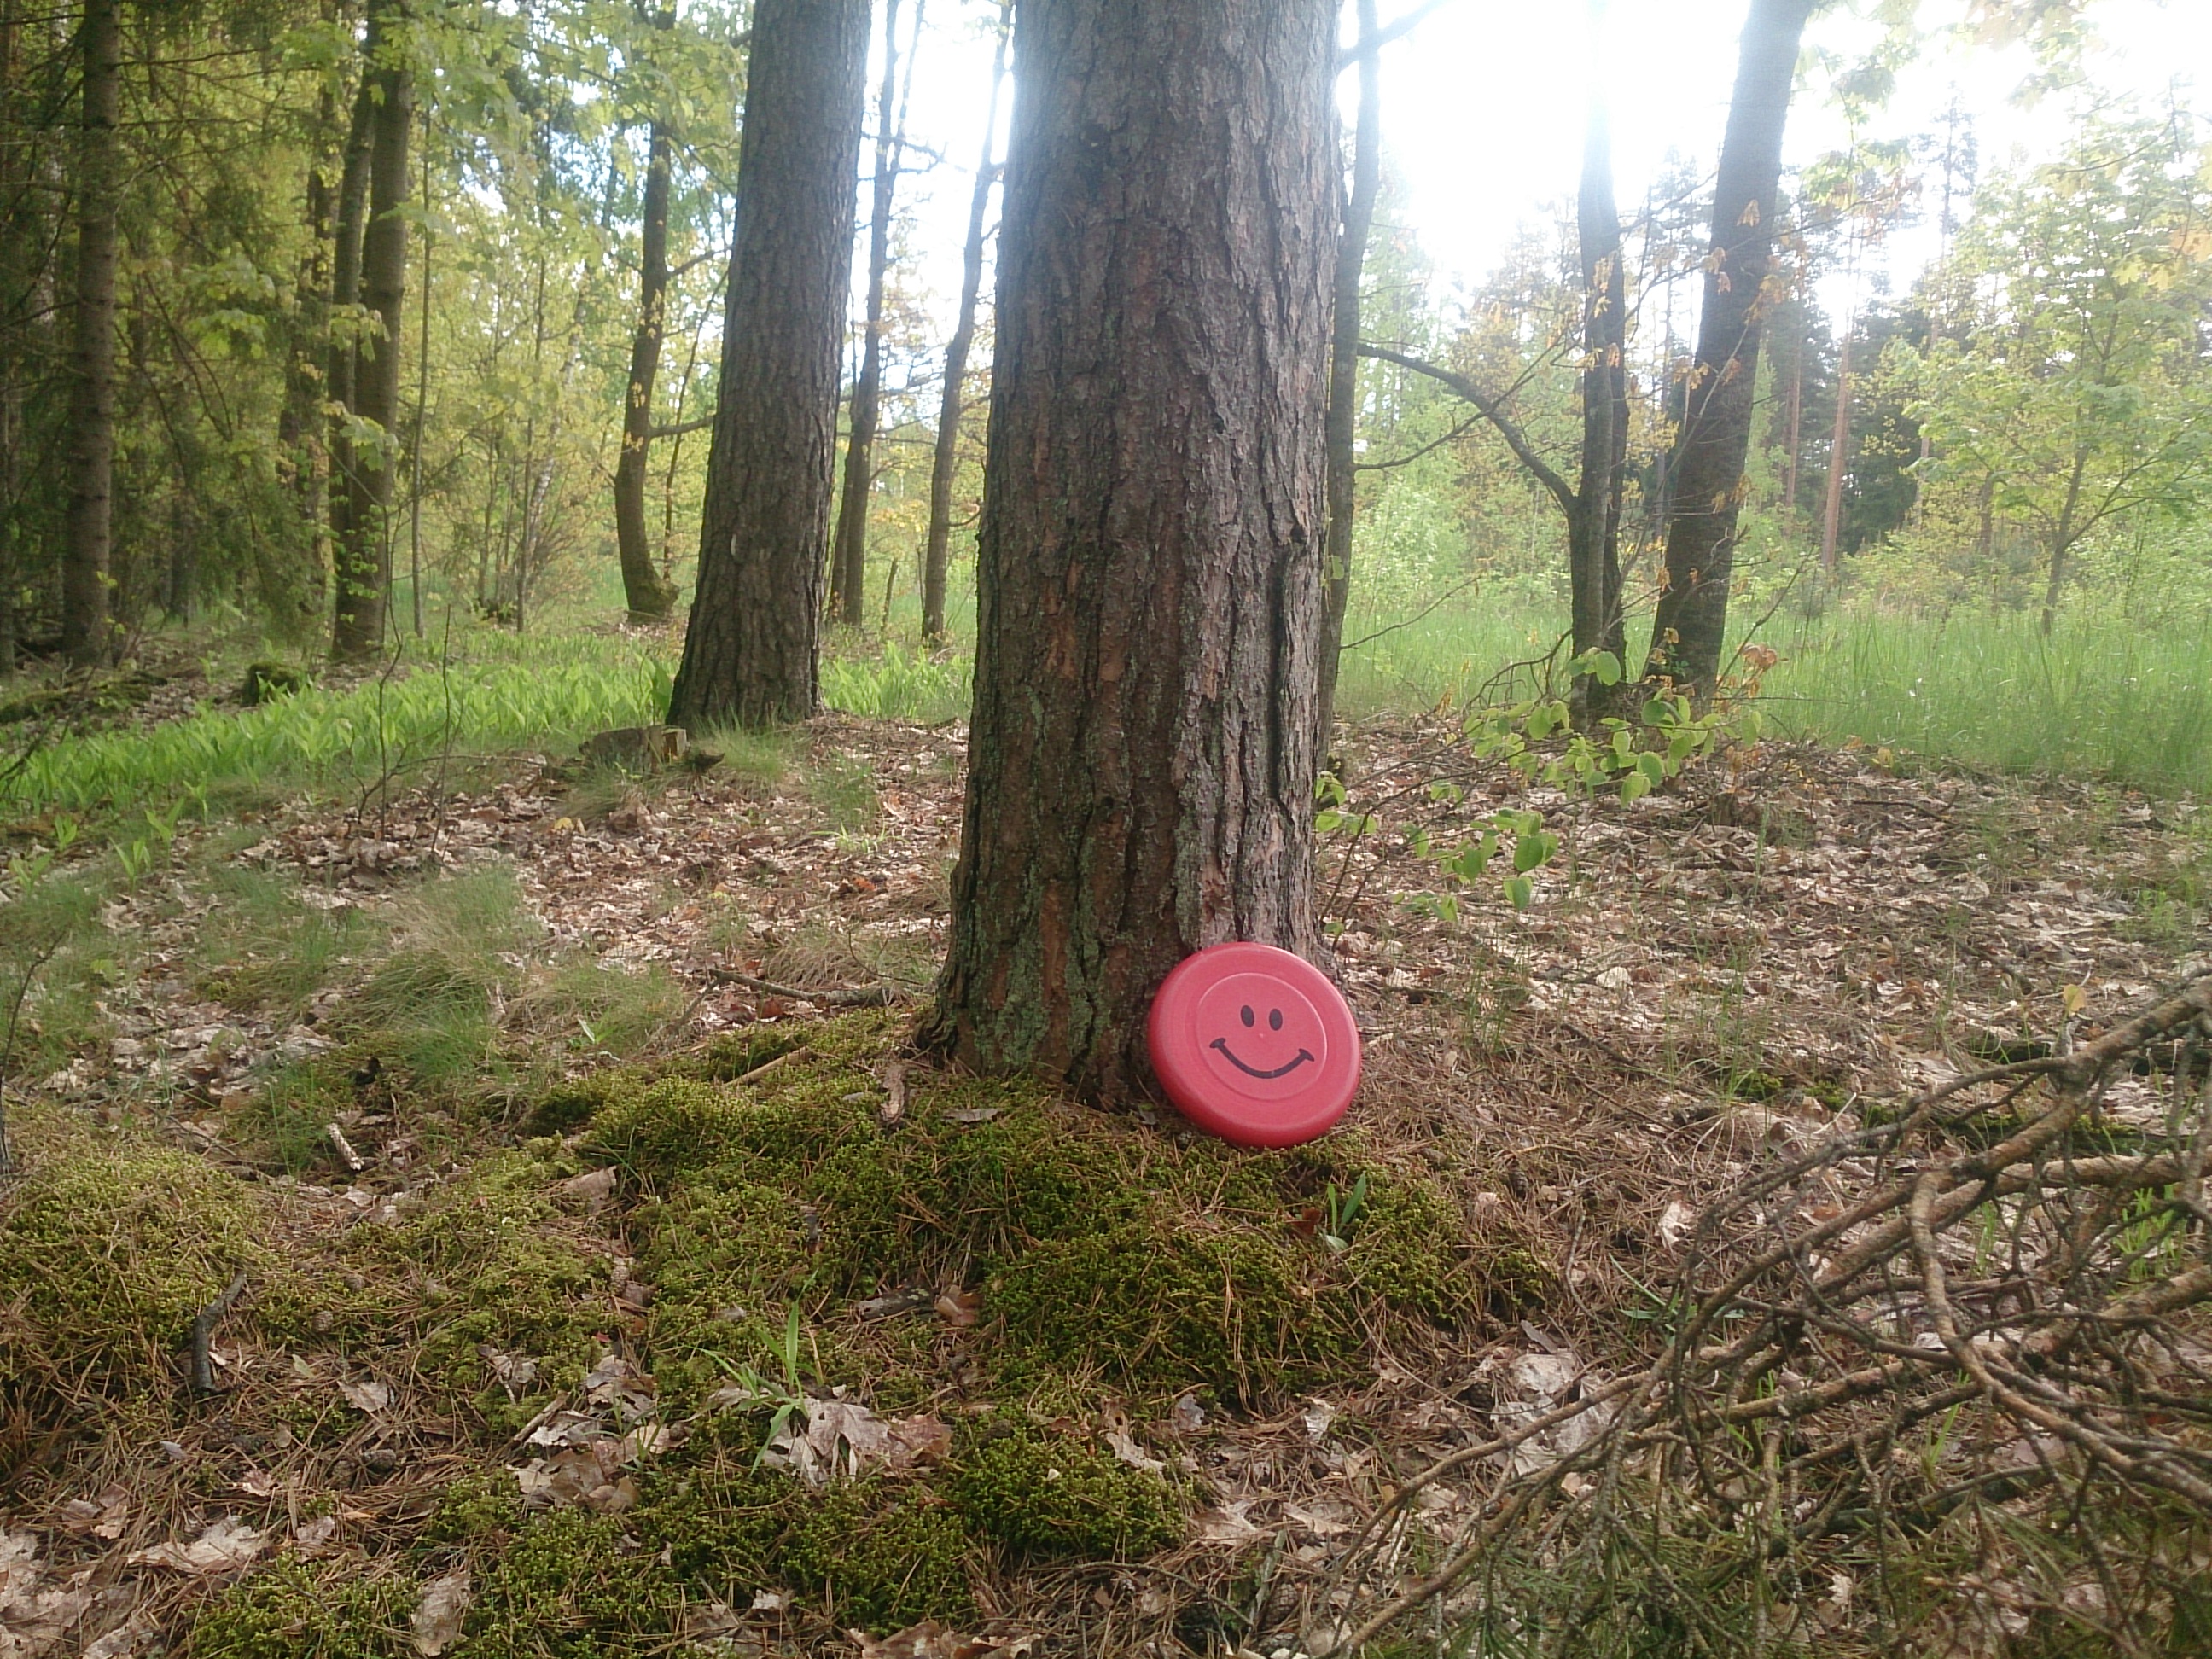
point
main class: Woodland
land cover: Pine dominated mixed woodland
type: hemiboreal forest and nemoral coniferous forest and mixed broadleaved-coniferous forest
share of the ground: > 75 %
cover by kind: coniferous forest trees 60 %, broadleaved forest trees 25 %, herbaceous plants 10 %, lichens and mosses 5 %
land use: Forestry
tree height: > 5 m
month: May
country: LV
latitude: 56.6689
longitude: 24.2371
